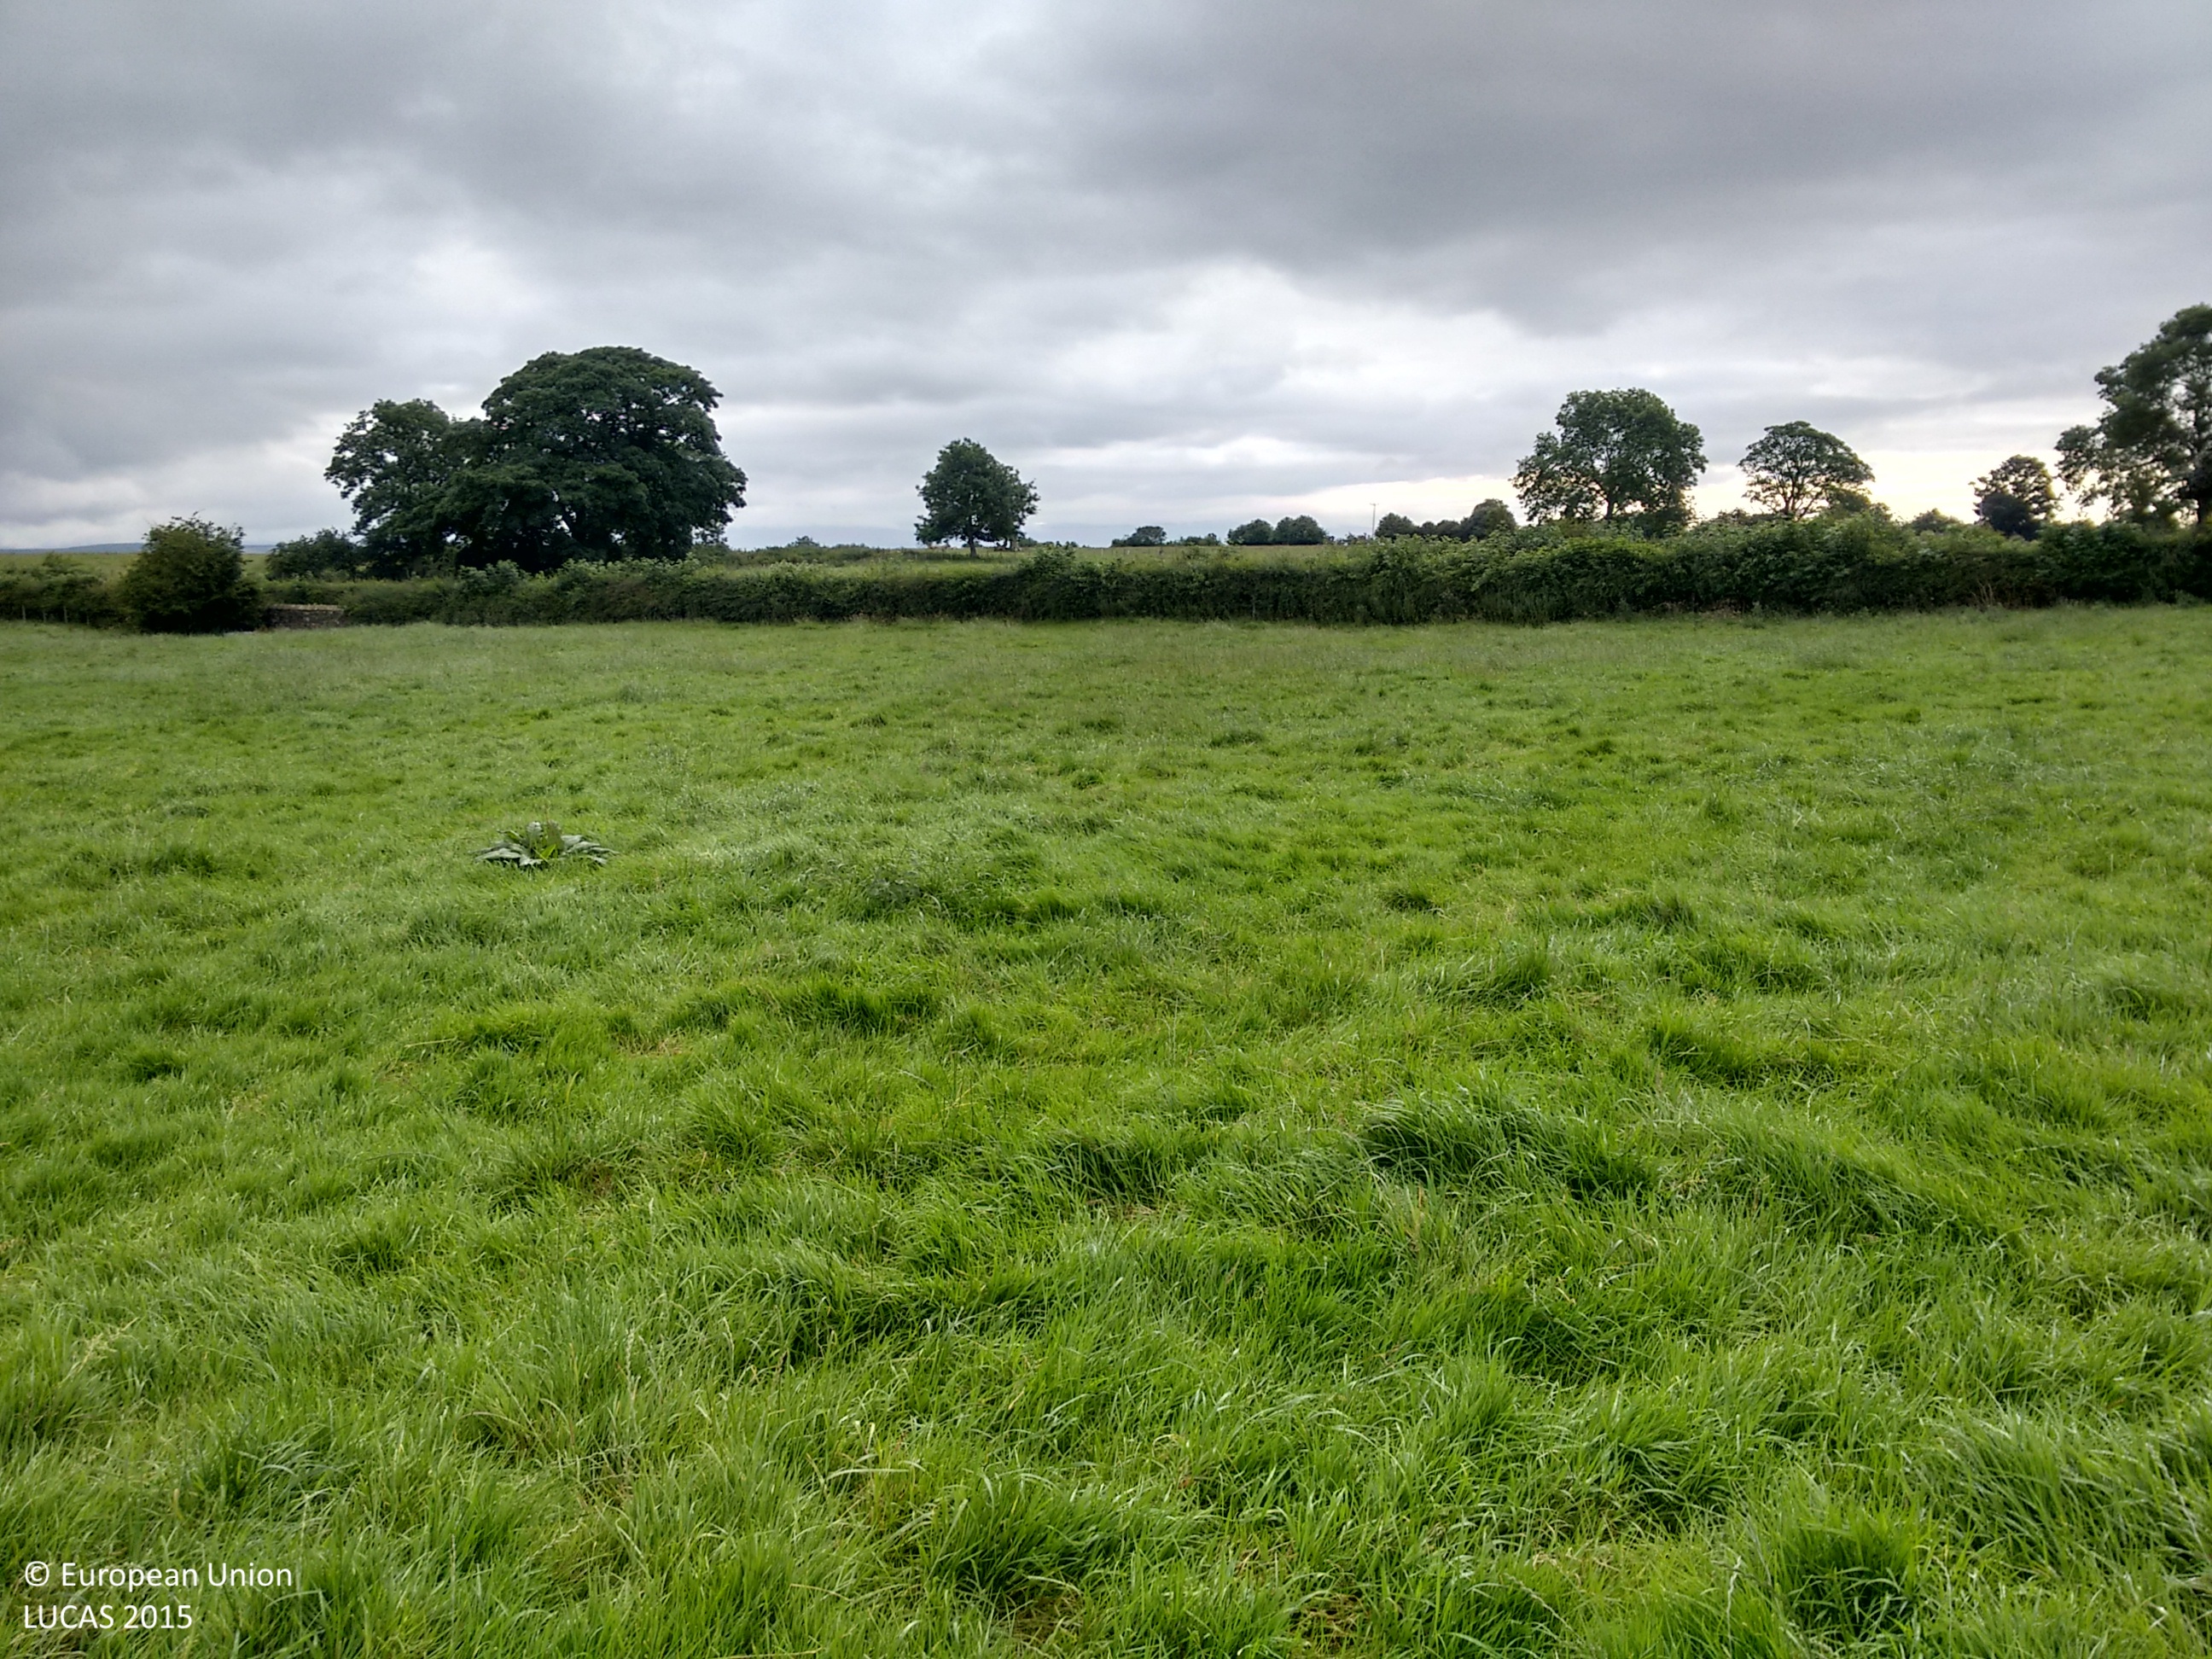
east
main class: Grassland
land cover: Grassland without tree/shrub cover
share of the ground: > 75 %
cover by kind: herbaceous plants 100 %
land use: Agriculture (excluding fallow land and kitchen gardens)
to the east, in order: Grassland without tree/shrub cover; Fences; Managed hedges; Grass margins; Paved roads, cycling and walking lanes; Grass margins; Managed hedges; Fences; Grassland without tree/shrub cover; Fences; Temporary grasslands
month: August
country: GB
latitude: 54.7152
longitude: -2.8763
